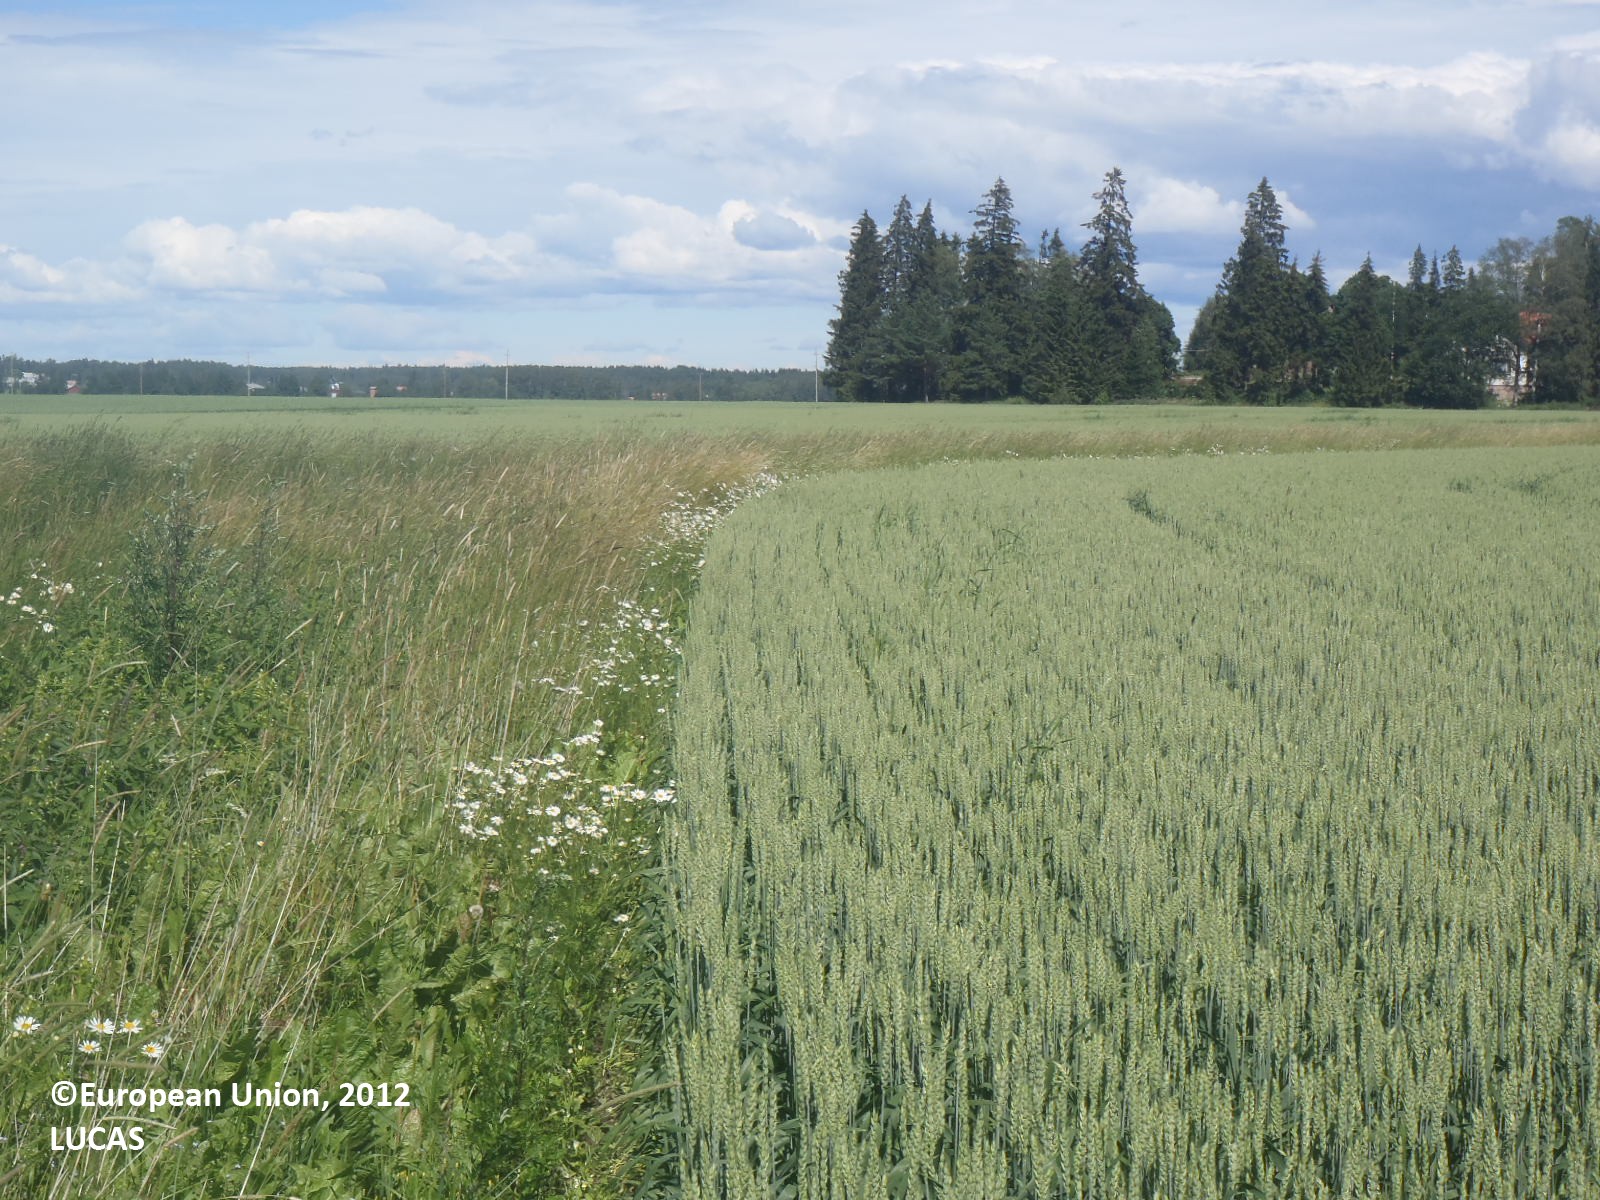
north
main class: Cropland
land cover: Common wheat
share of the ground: > 75 %
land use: Agriculture (excluding fallow land and kitchen gardens)
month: July
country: FI
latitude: 61.2032
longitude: 21.9496
